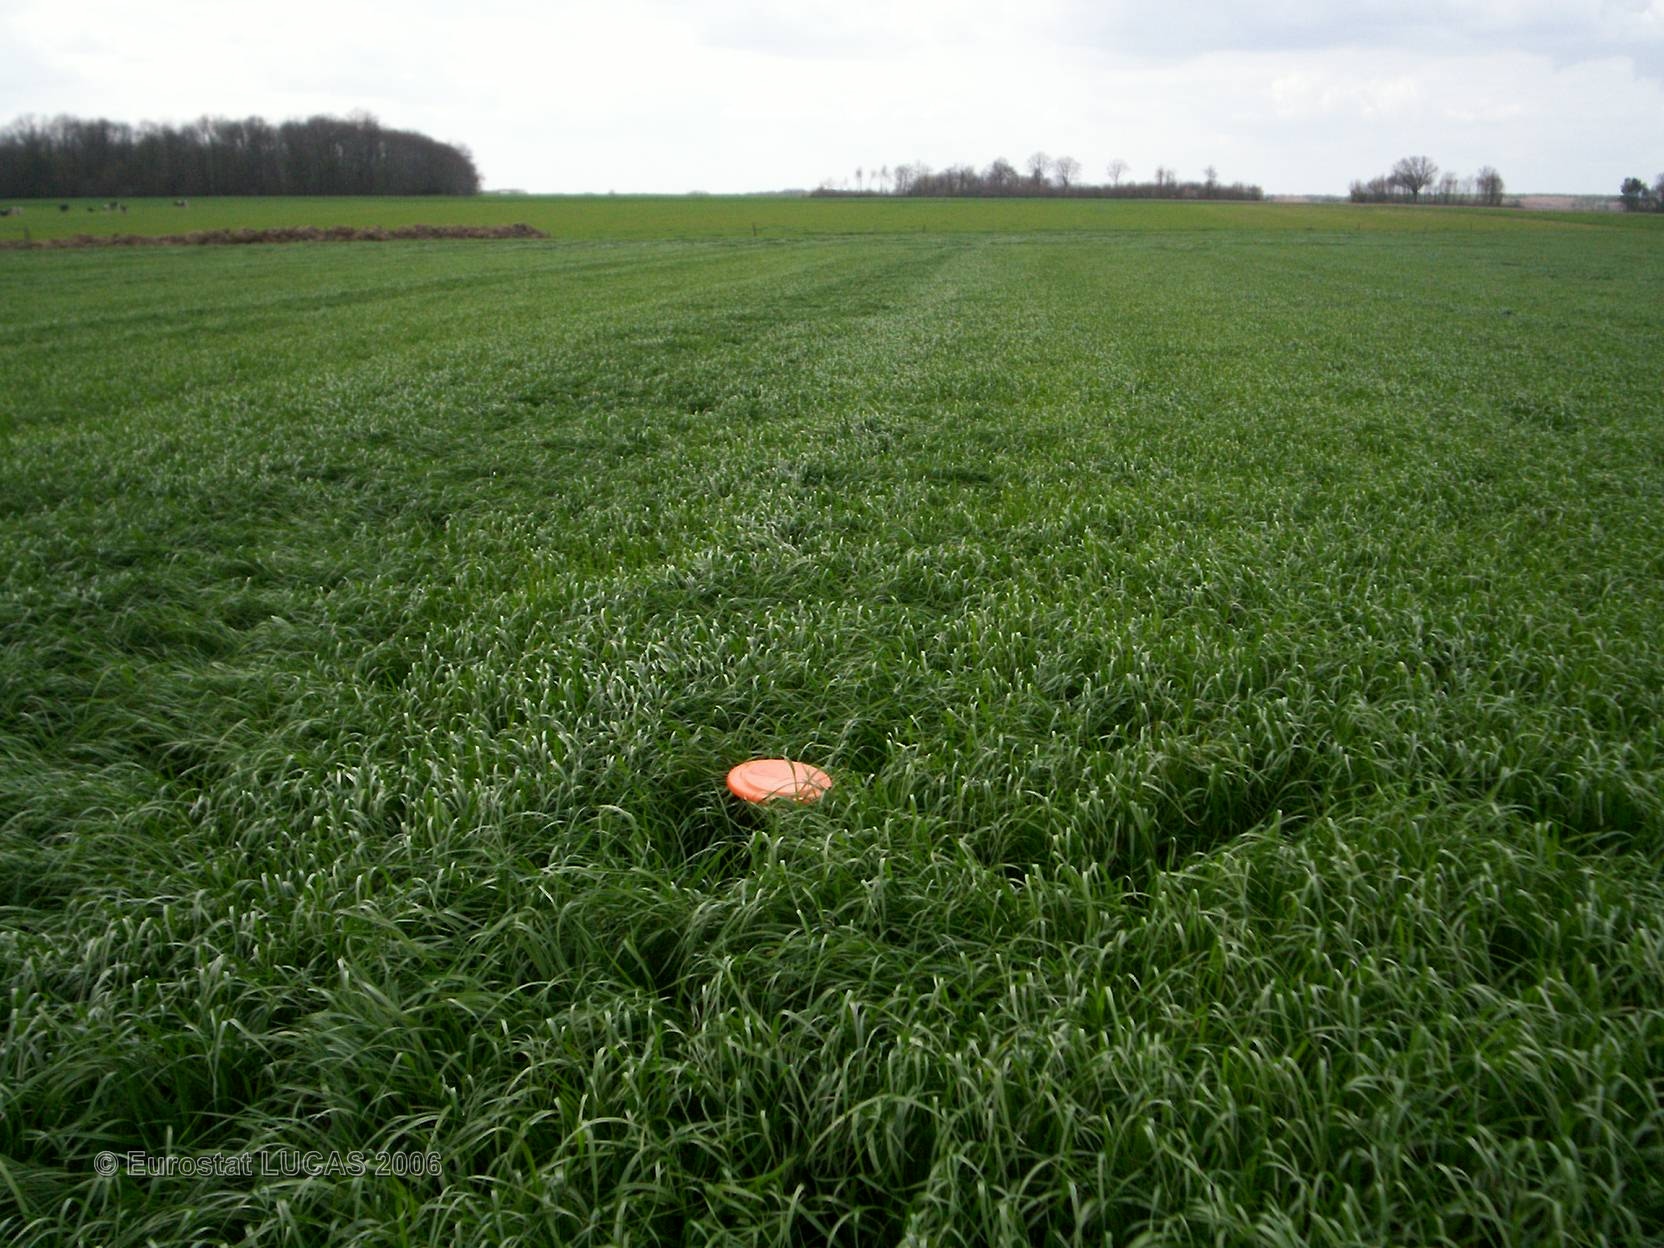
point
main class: Grassland
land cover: Grassland without tree/shrub cover
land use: Agriculture (excluding fallow land and kitchen gardens)
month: April
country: FR
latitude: 47.0396
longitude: 0.9954
